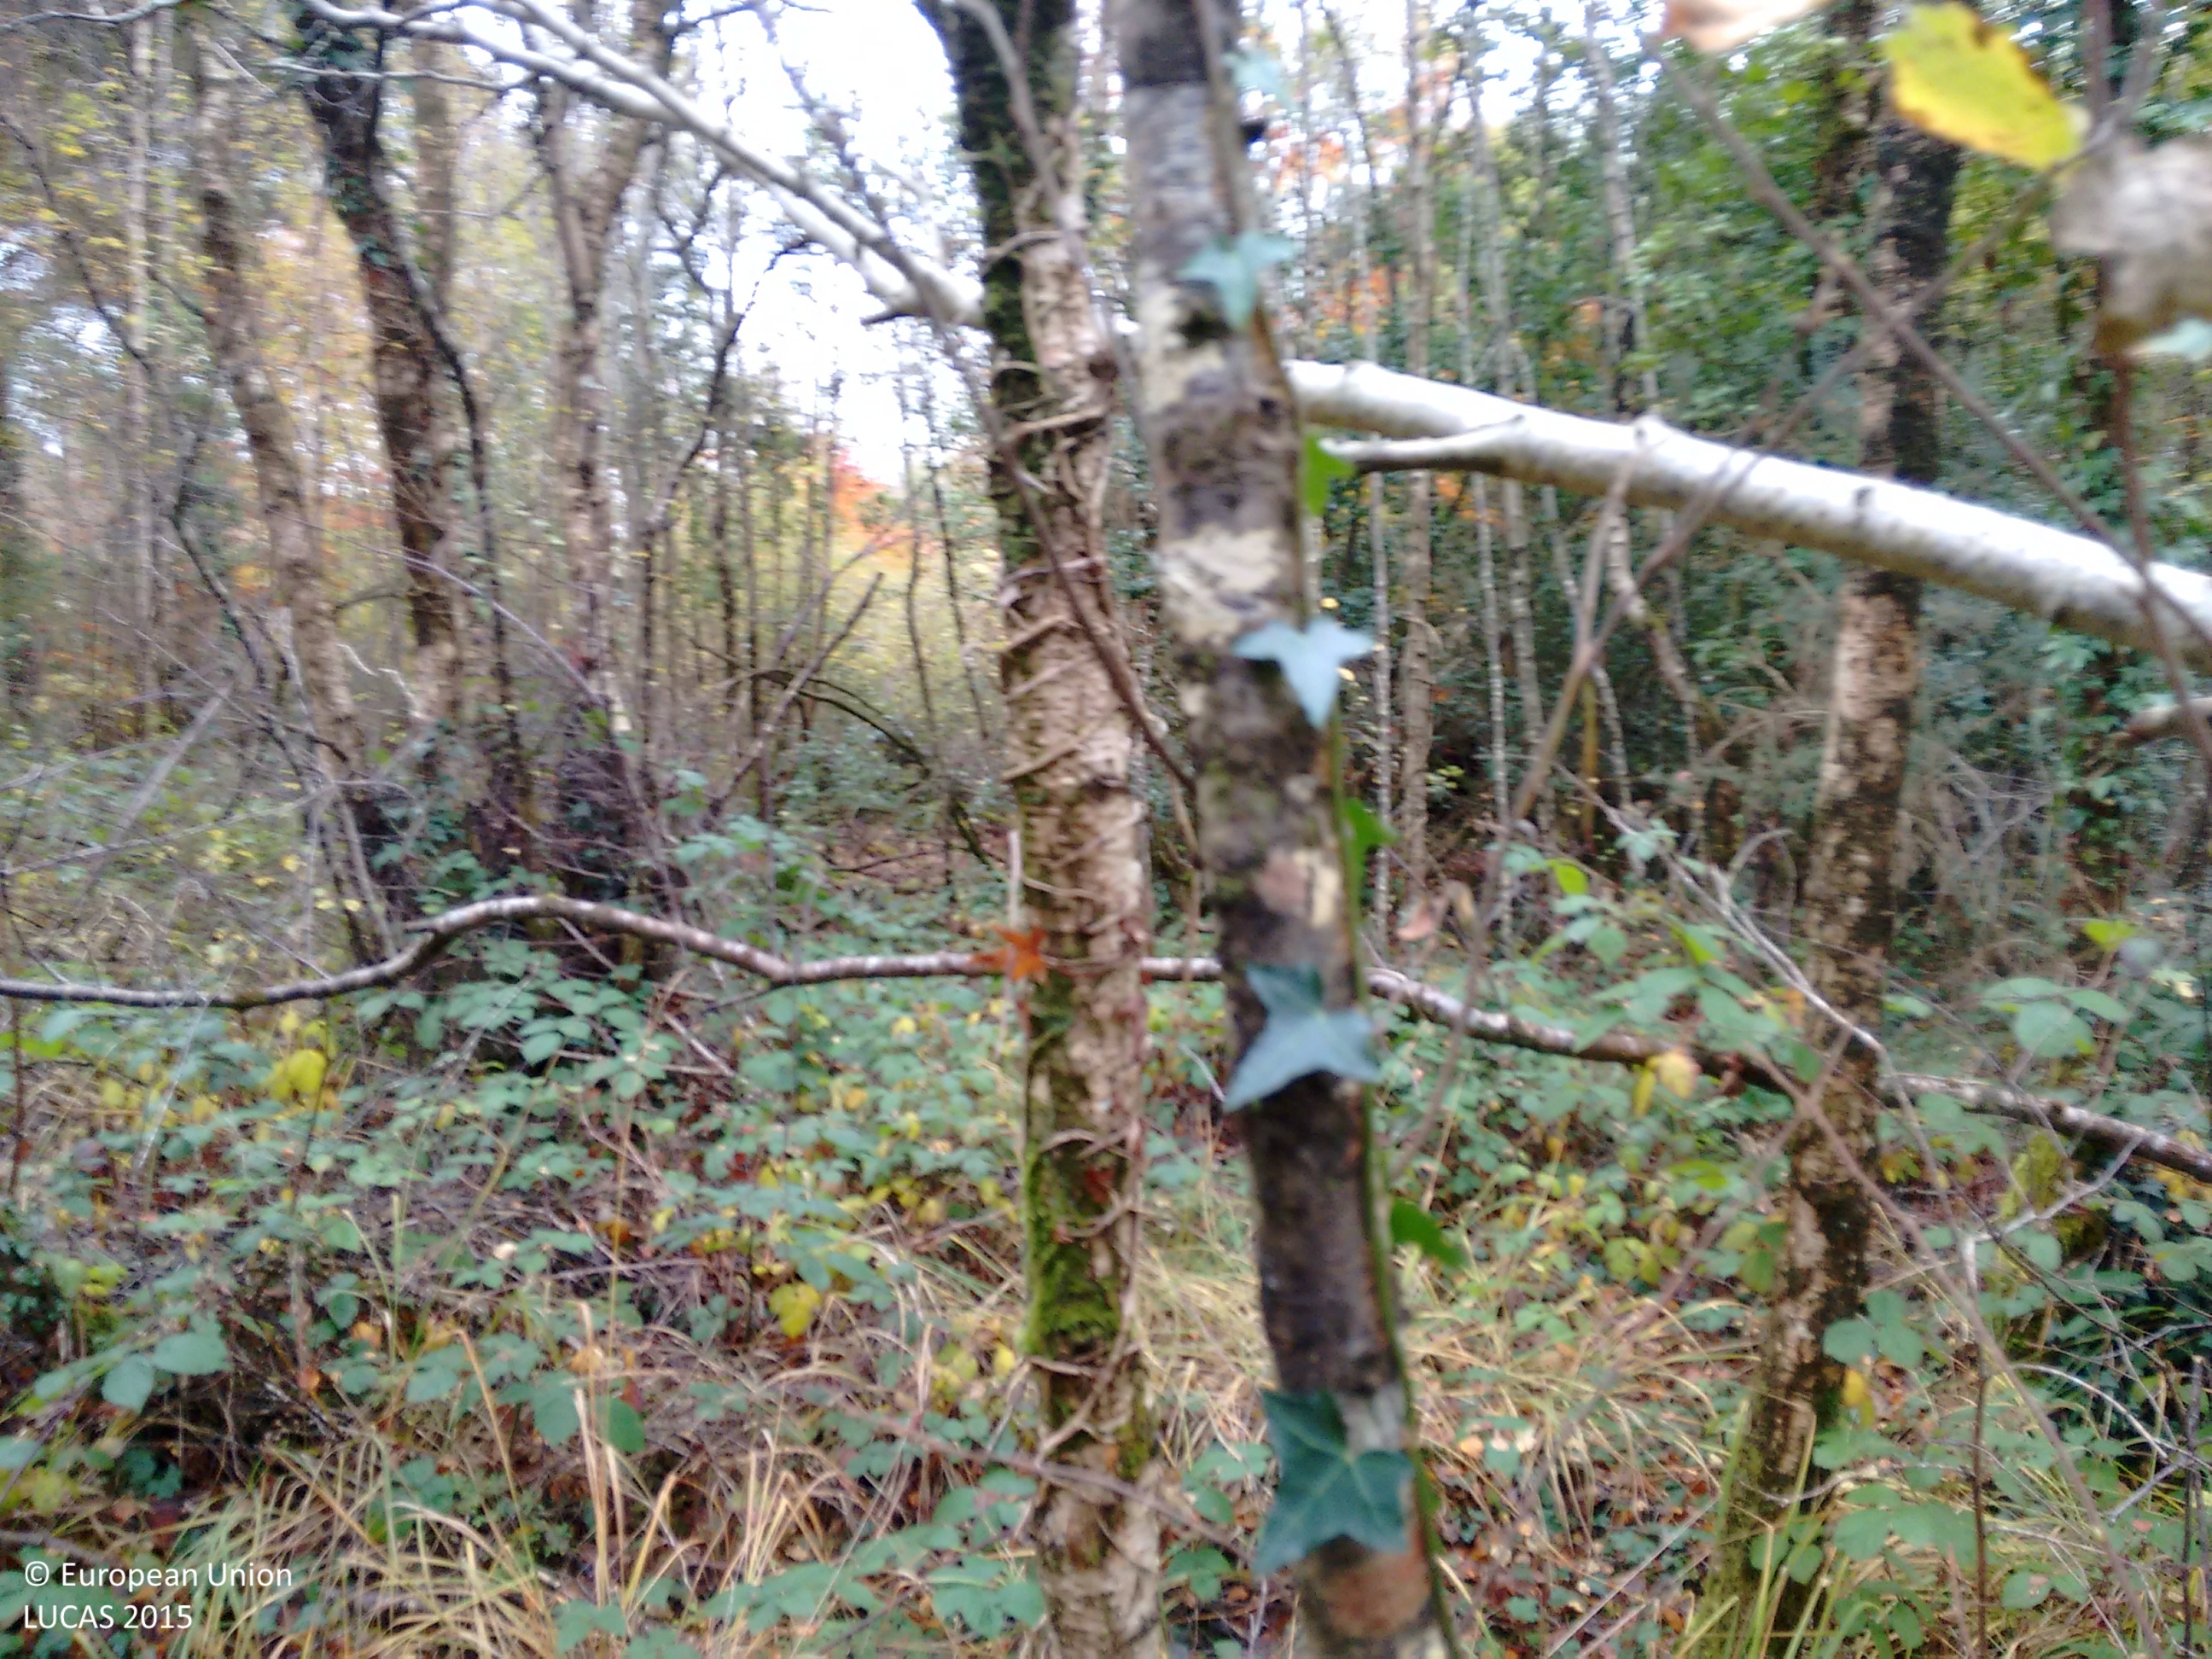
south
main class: Woodland
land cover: Other mixed woodland
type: acidophilous oak and oak-birch forest
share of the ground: > 75 %
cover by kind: broadleaved forest trees 60 %, coniferous forest trees 40 %
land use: Semi-natural and natural areas not in use
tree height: > 5 m
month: October
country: IE
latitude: 53.2248
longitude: -7.5812
